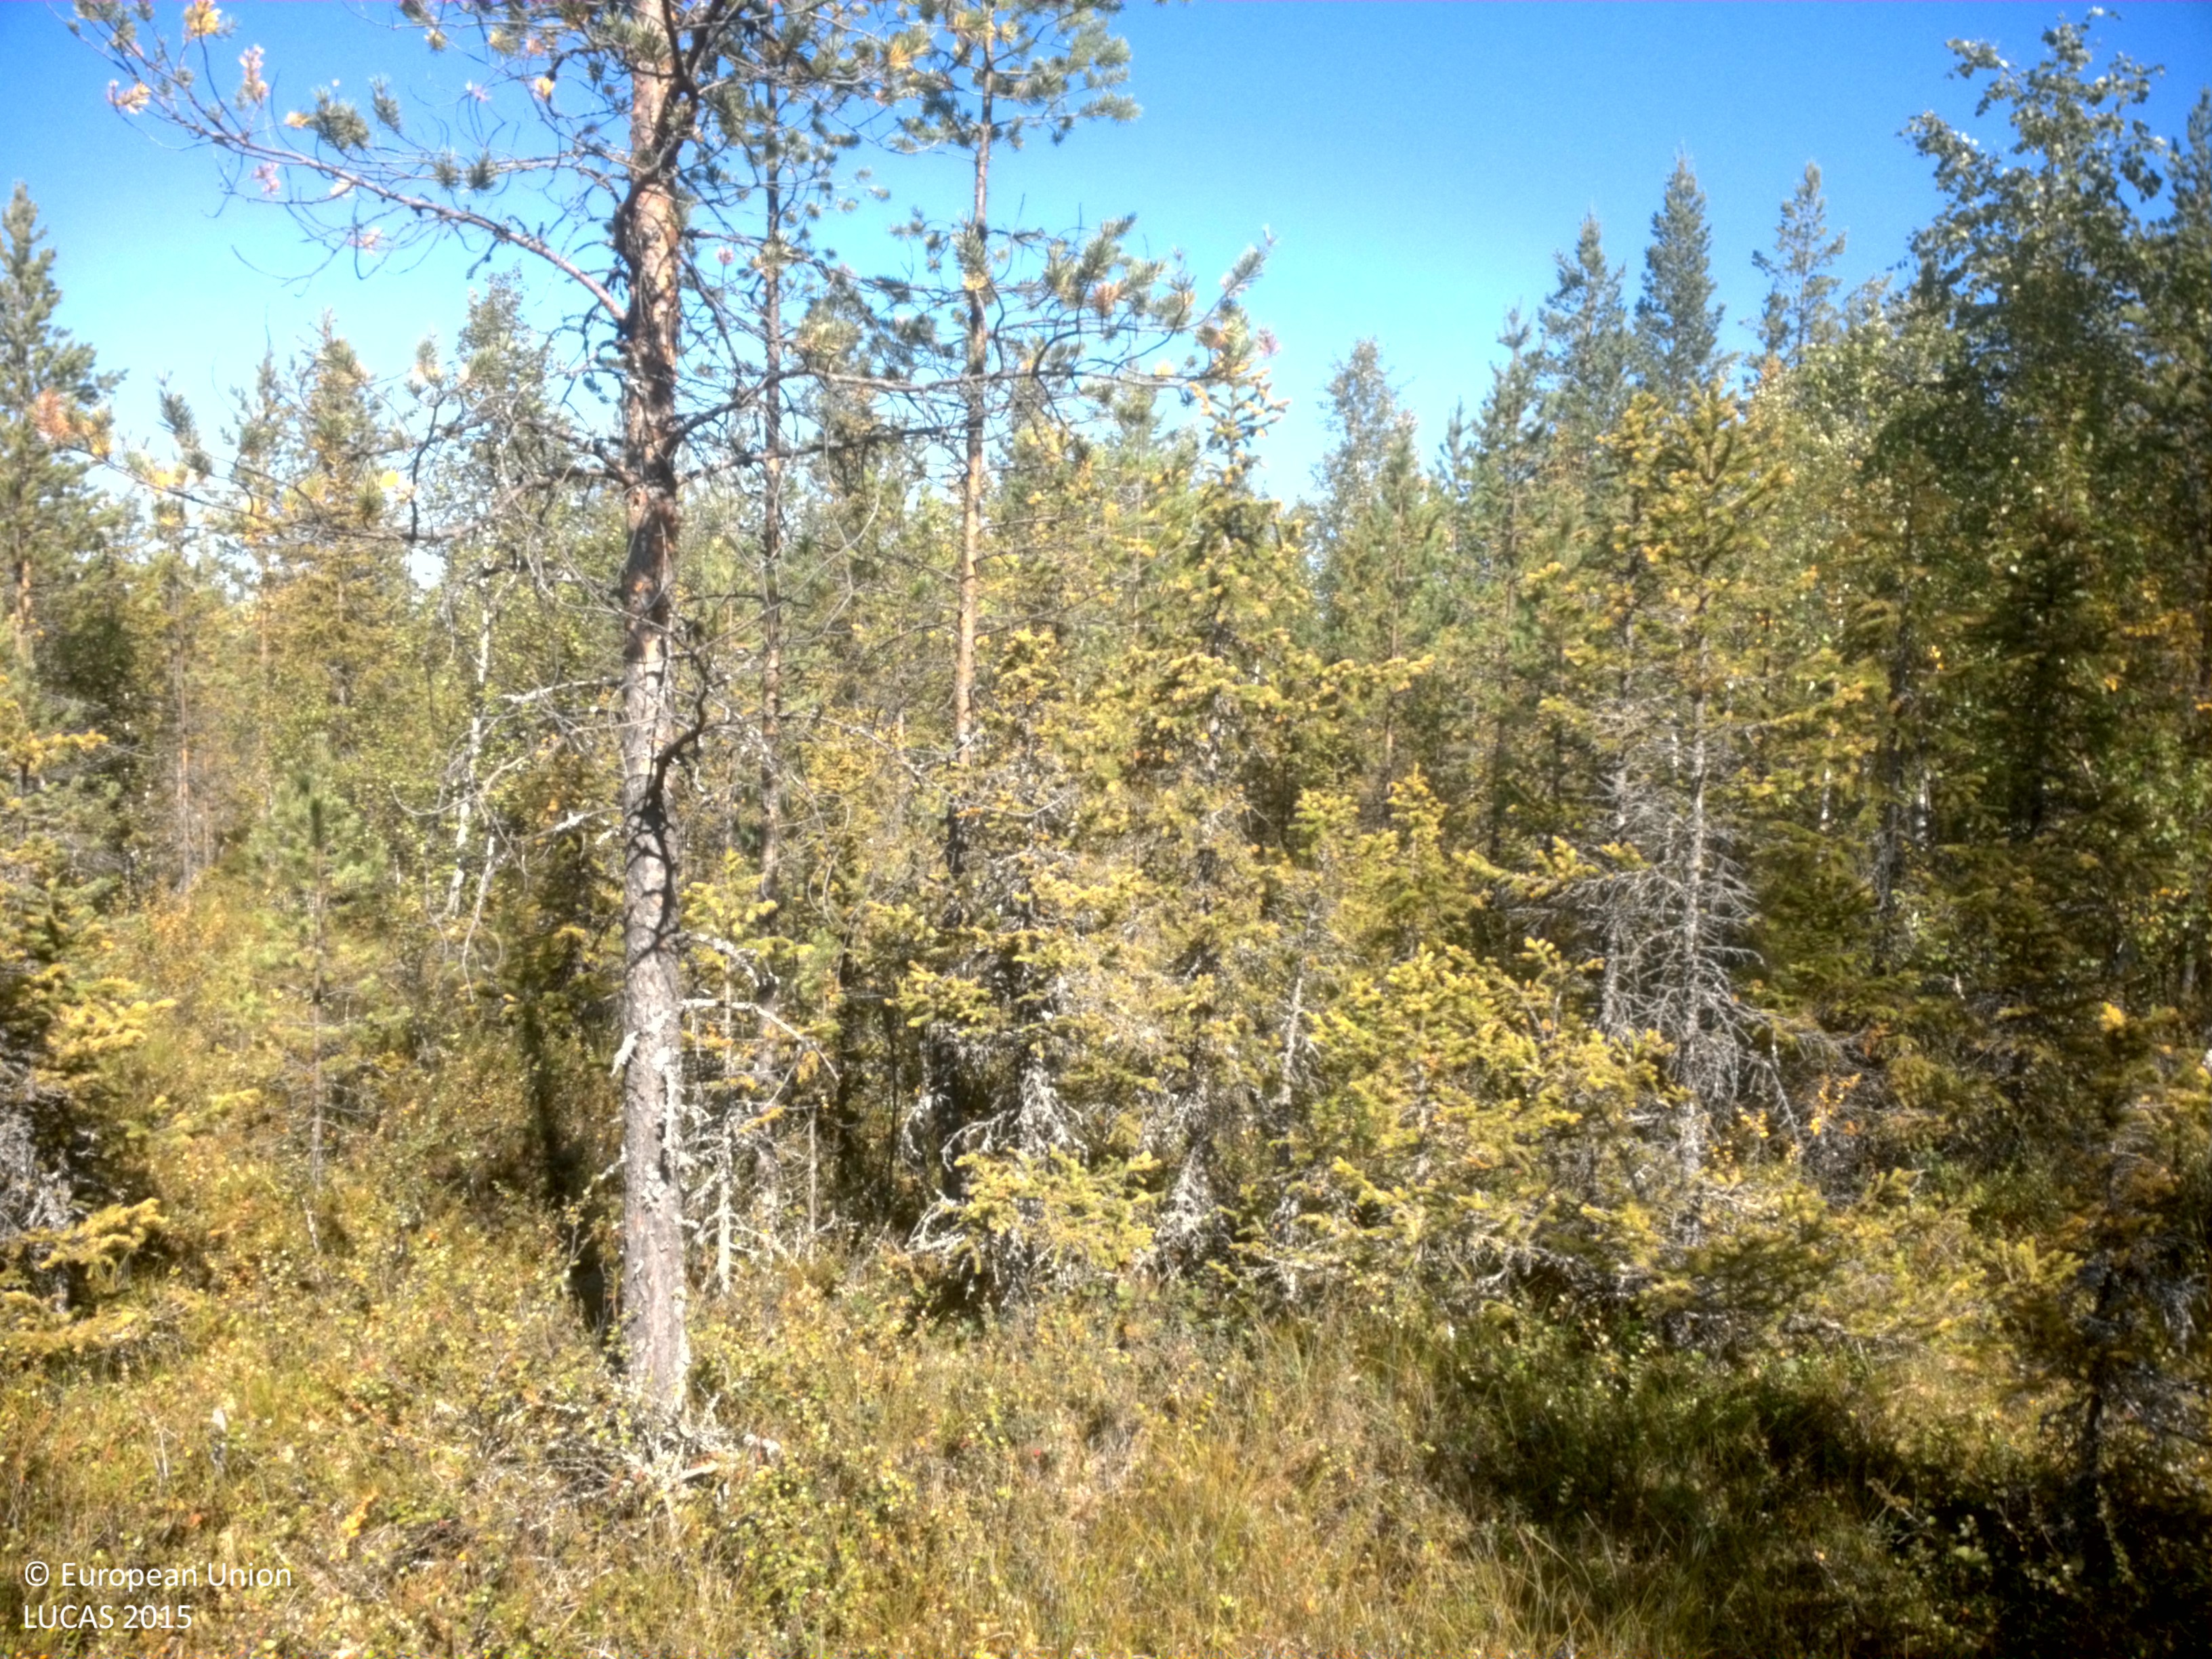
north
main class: Woodland
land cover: Pine dominated coniferous woodland
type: boreal forest
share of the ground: 50 - 75 %
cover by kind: coniferous forest trees 60 %, shrubs 20 %, herbaceous plants 10 %, lichens and mosses 10 %
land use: Forestry
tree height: > 5 m
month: August
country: SE
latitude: 64.6950
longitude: 18.8791
